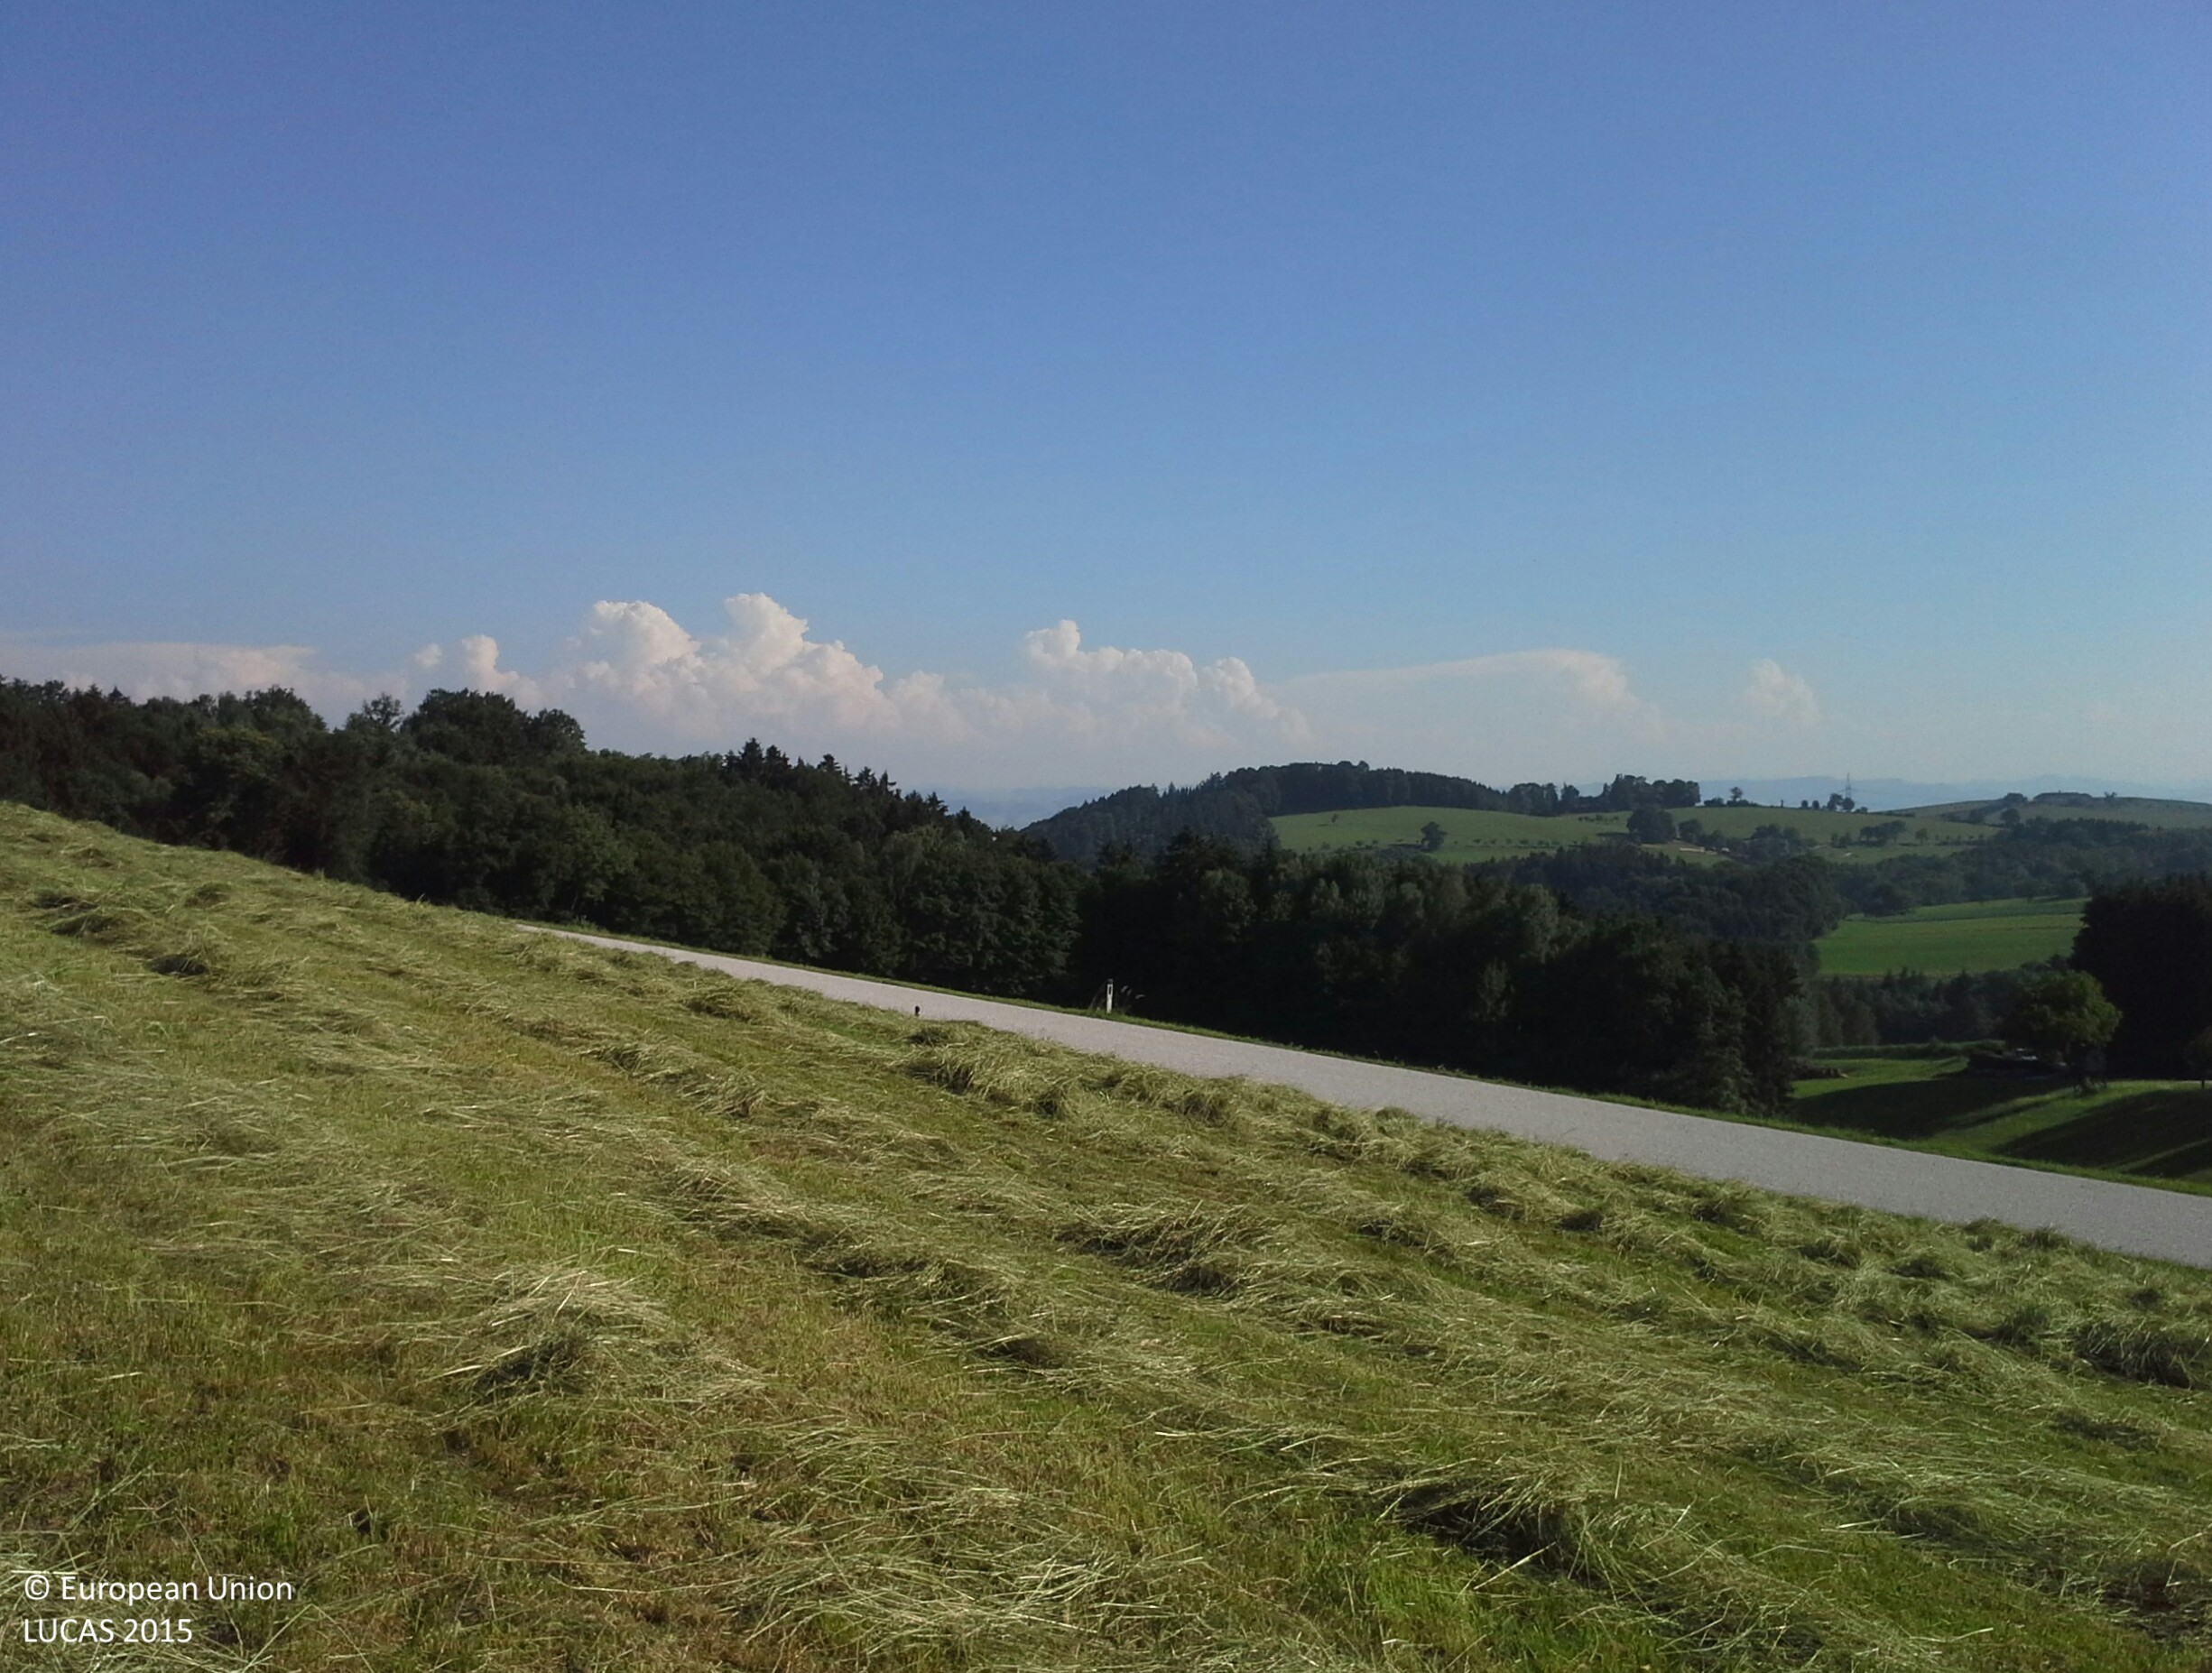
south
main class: Grassland
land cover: Grassland without tree/shrub cover
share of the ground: > 75 %
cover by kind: herbaceous plants 100 %
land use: Agriculture (excluding fallow land and kitchen gardens)
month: July
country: AT
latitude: 48.1659
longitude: 14.9625
